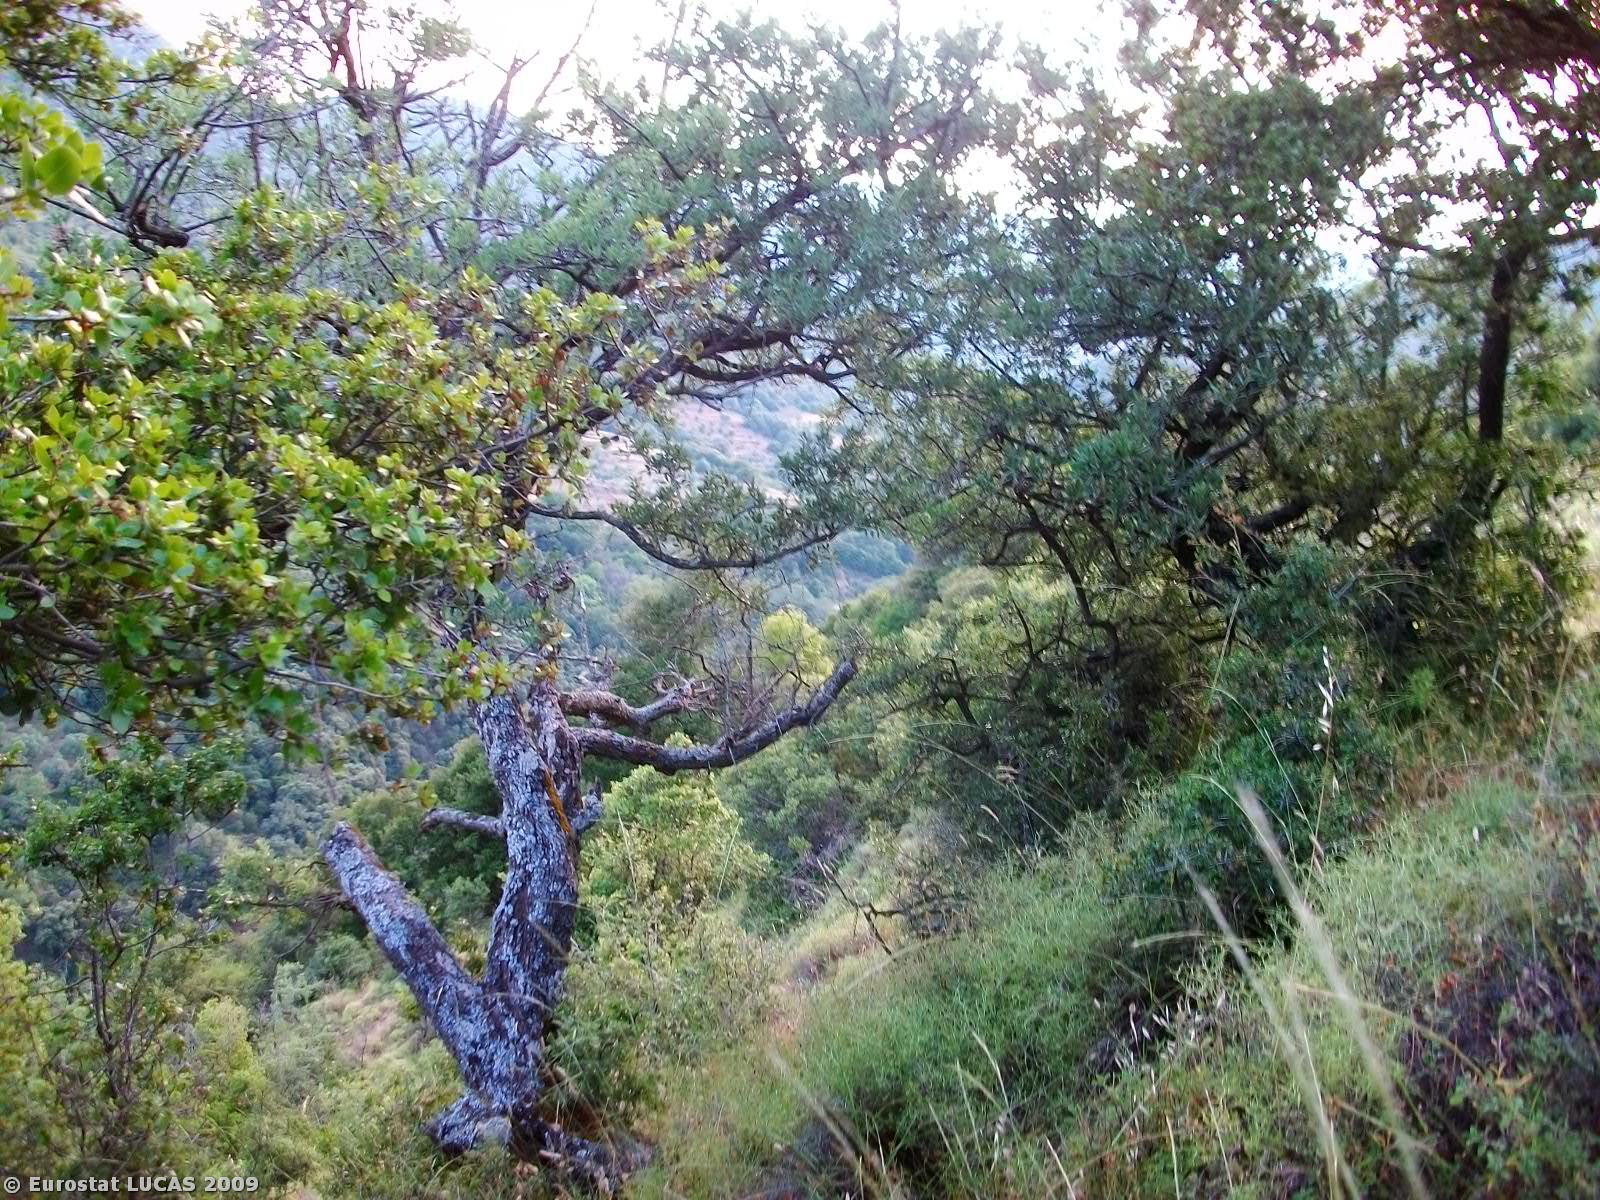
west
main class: Shrubland
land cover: Shrubland with sparse tree cover
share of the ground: > 75 %
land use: Agriculture (excluding fallow land and kitchen gardens)
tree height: < 5 m
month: July
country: GR
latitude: 38.4303
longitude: 22.1495
